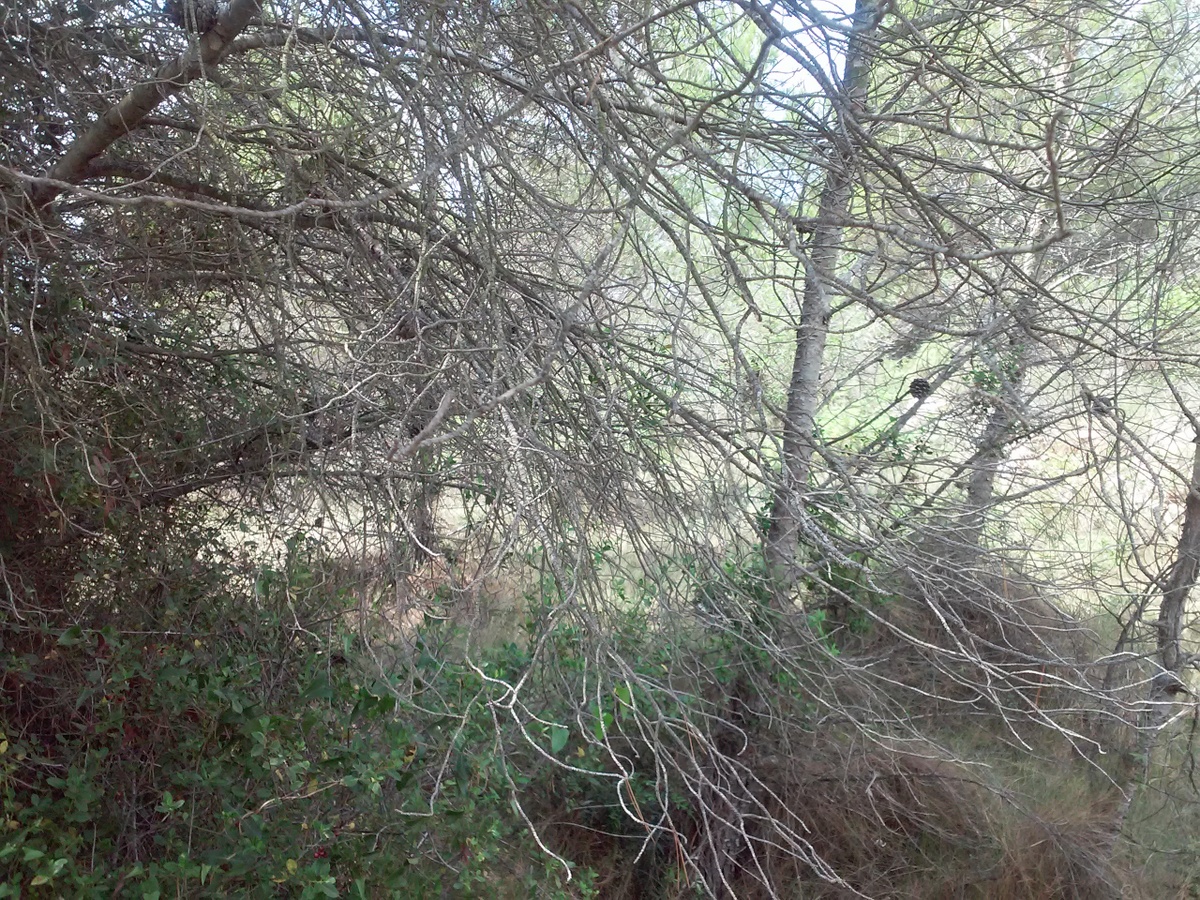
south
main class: Woodland
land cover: Pine dominated coniferous woodland
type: coniferous forest of the mediterranean region
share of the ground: 25 - 50 %
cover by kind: coniferous forest trees 35 %, shrubs 25 %, herbaceous plants 15 %, broadleaved forest trees 10 %, lichens and mosses 10 %, consolidated bare surface 5 %
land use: Semi-natural and natural areas not in use
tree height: < 5 m
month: July
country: ES
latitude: 41.1335
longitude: 1.2858
